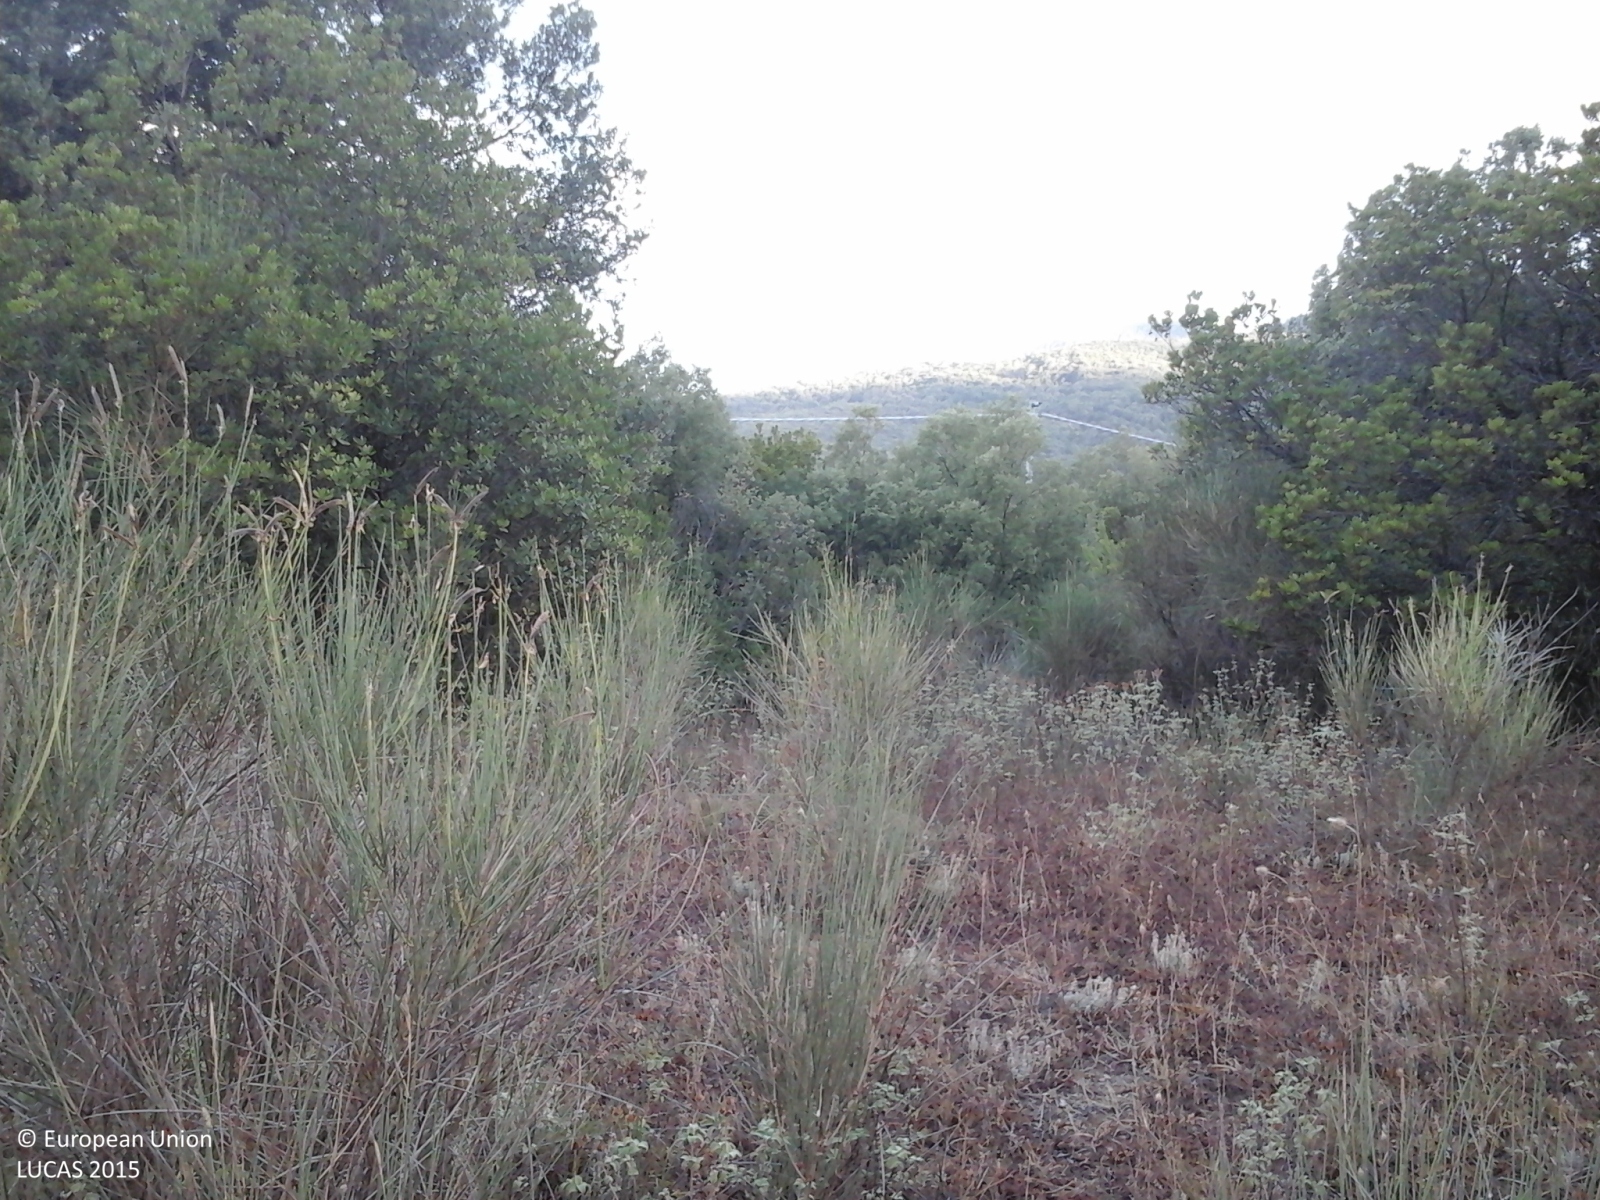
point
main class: Woodland
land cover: Other mixed woodland
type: thermophilous deciduous forest
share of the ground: > 75 %
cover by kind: broadleaved forest trees 60 %, coniferous forest trees 40 %
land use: Forestry
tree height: > 5 m
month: July
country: IT
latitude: 43.4804
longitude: 10.9246
